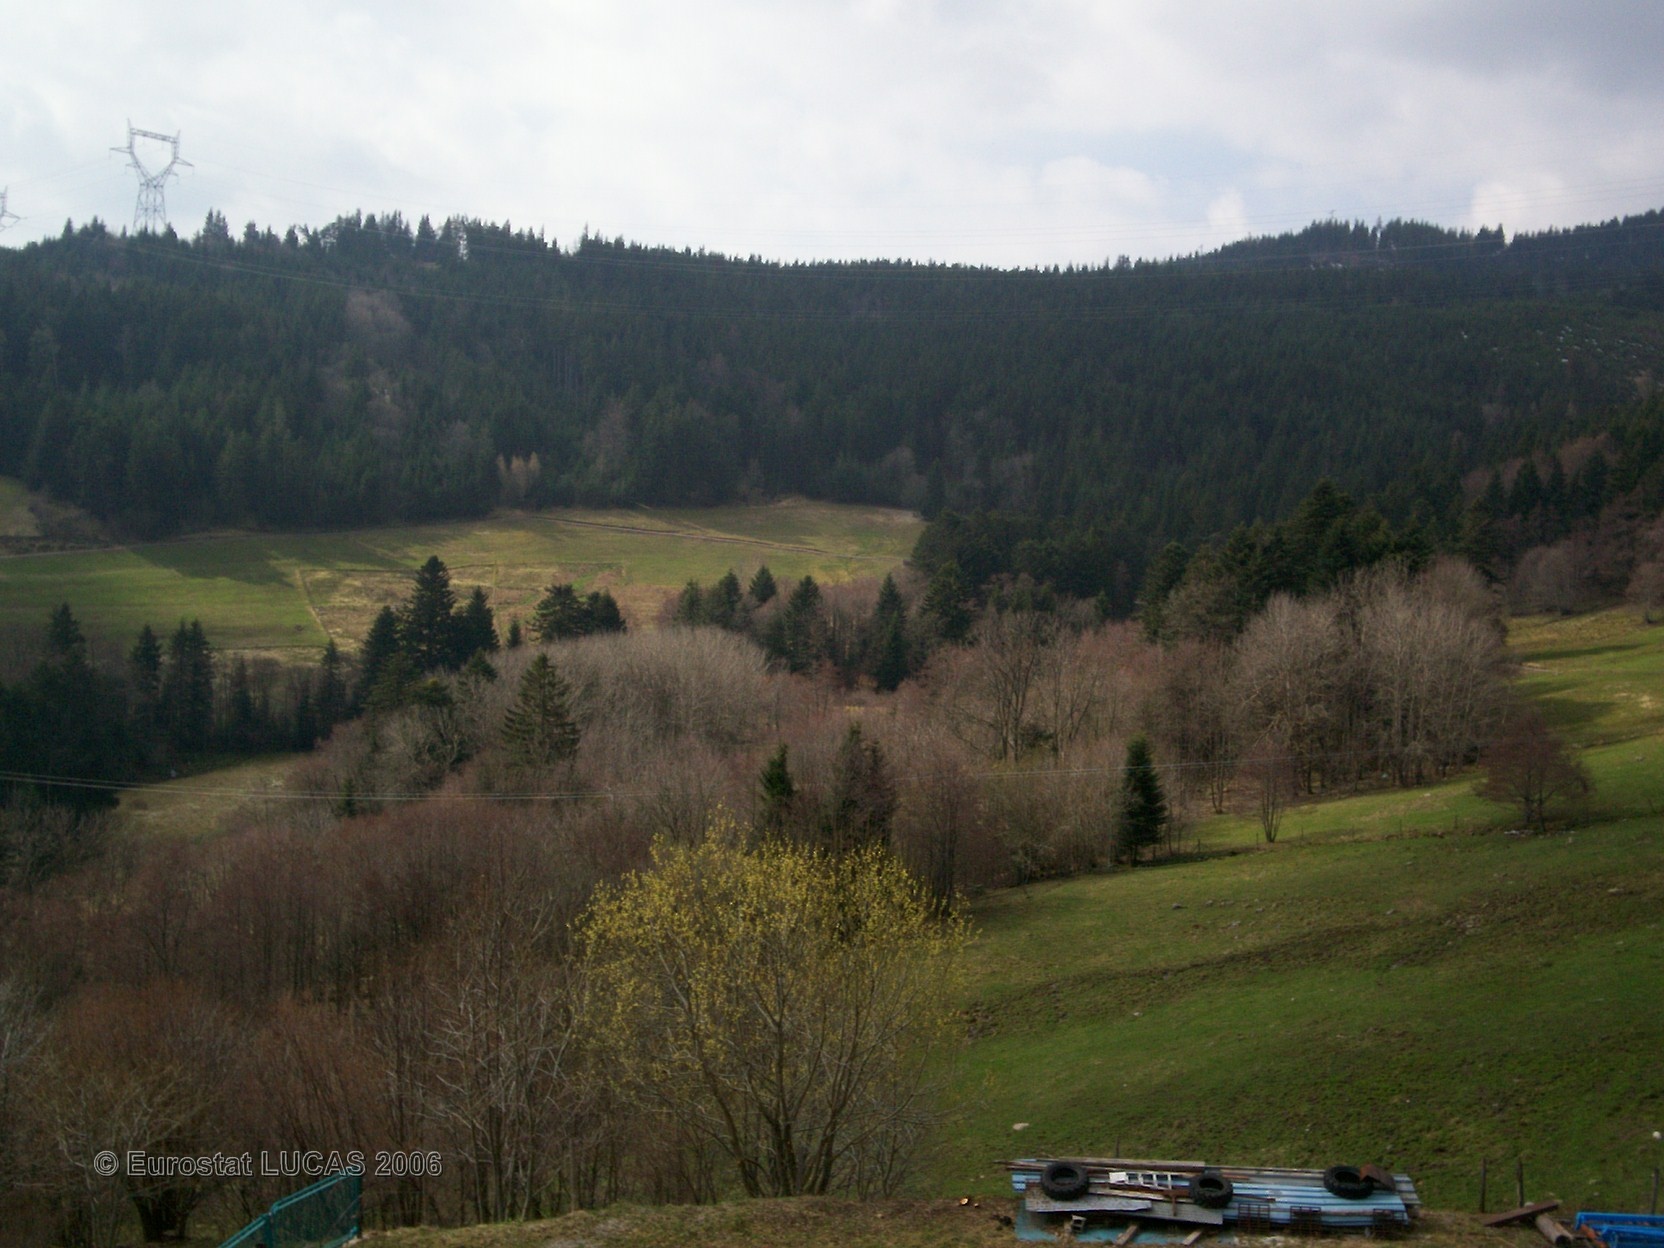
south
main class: Grassland
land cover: Grassland without tree/shrub cover
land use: Agriculture (excluding fallow land and kitchen gardens)
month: April
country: FR
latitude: 48.1317
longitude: 7.1122
